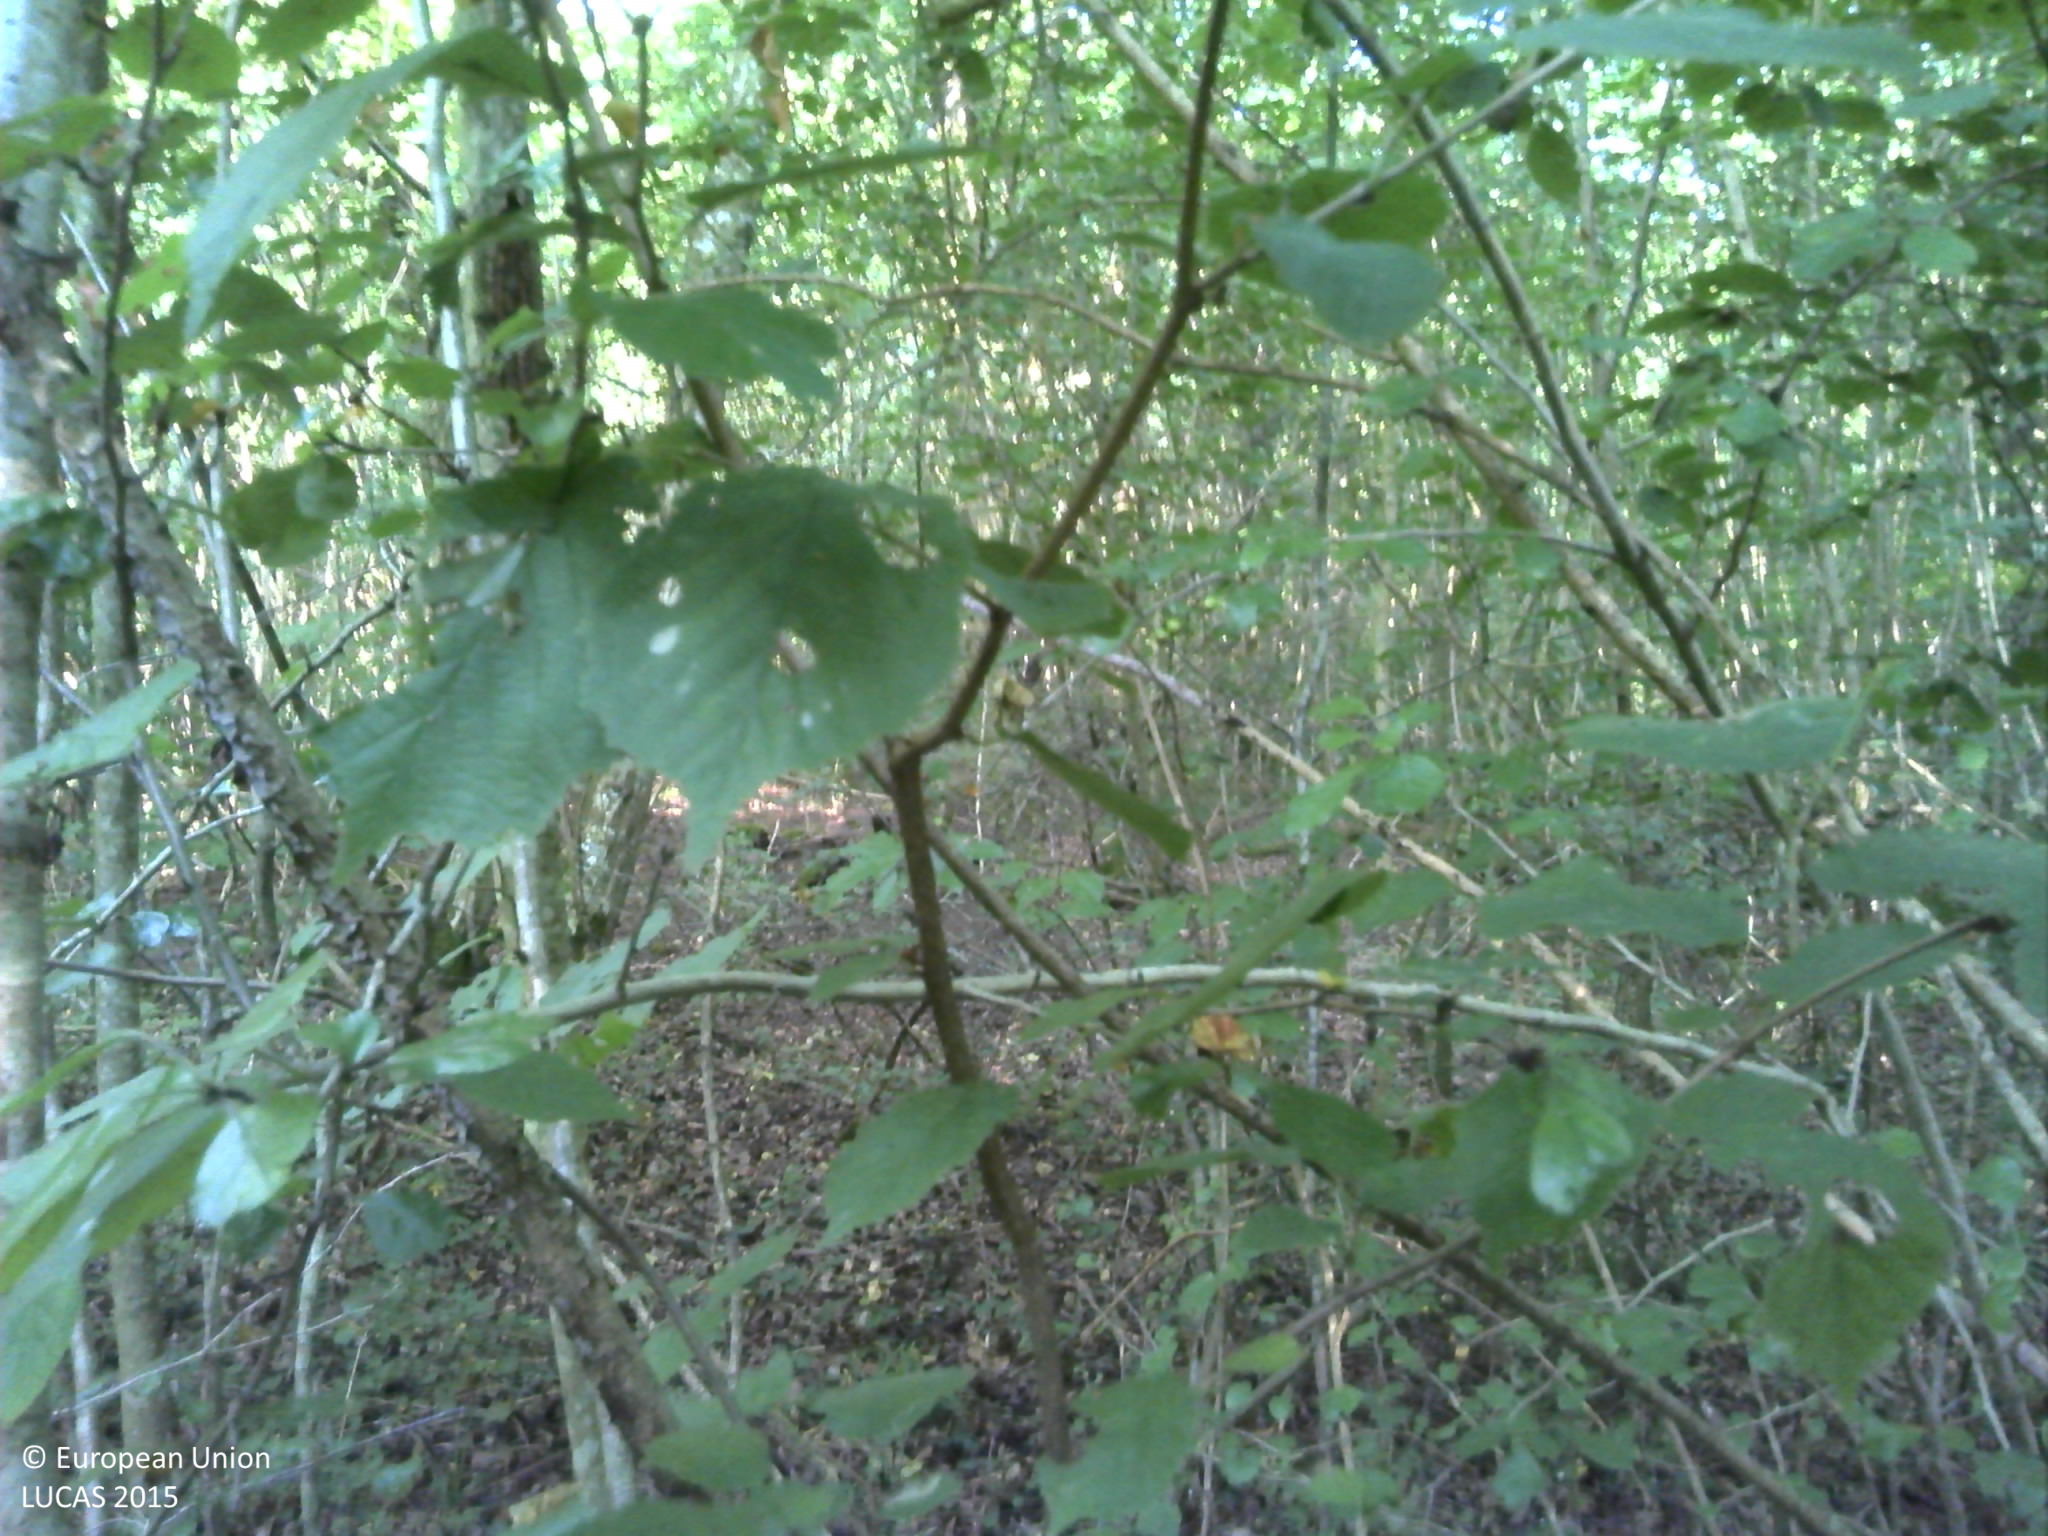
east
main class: Woodland
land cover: Broadleaved woodland
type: acidophilous oak and oak-birch forest
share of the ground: > 75 %
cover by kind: broadleaved forest trees 100 %
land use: Forestry
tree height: > 5 m
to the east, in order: Broadleaved woodland; Tracks; Broadleaved woodland
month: July
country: FR
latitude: 48.8980
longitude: 6.8220
